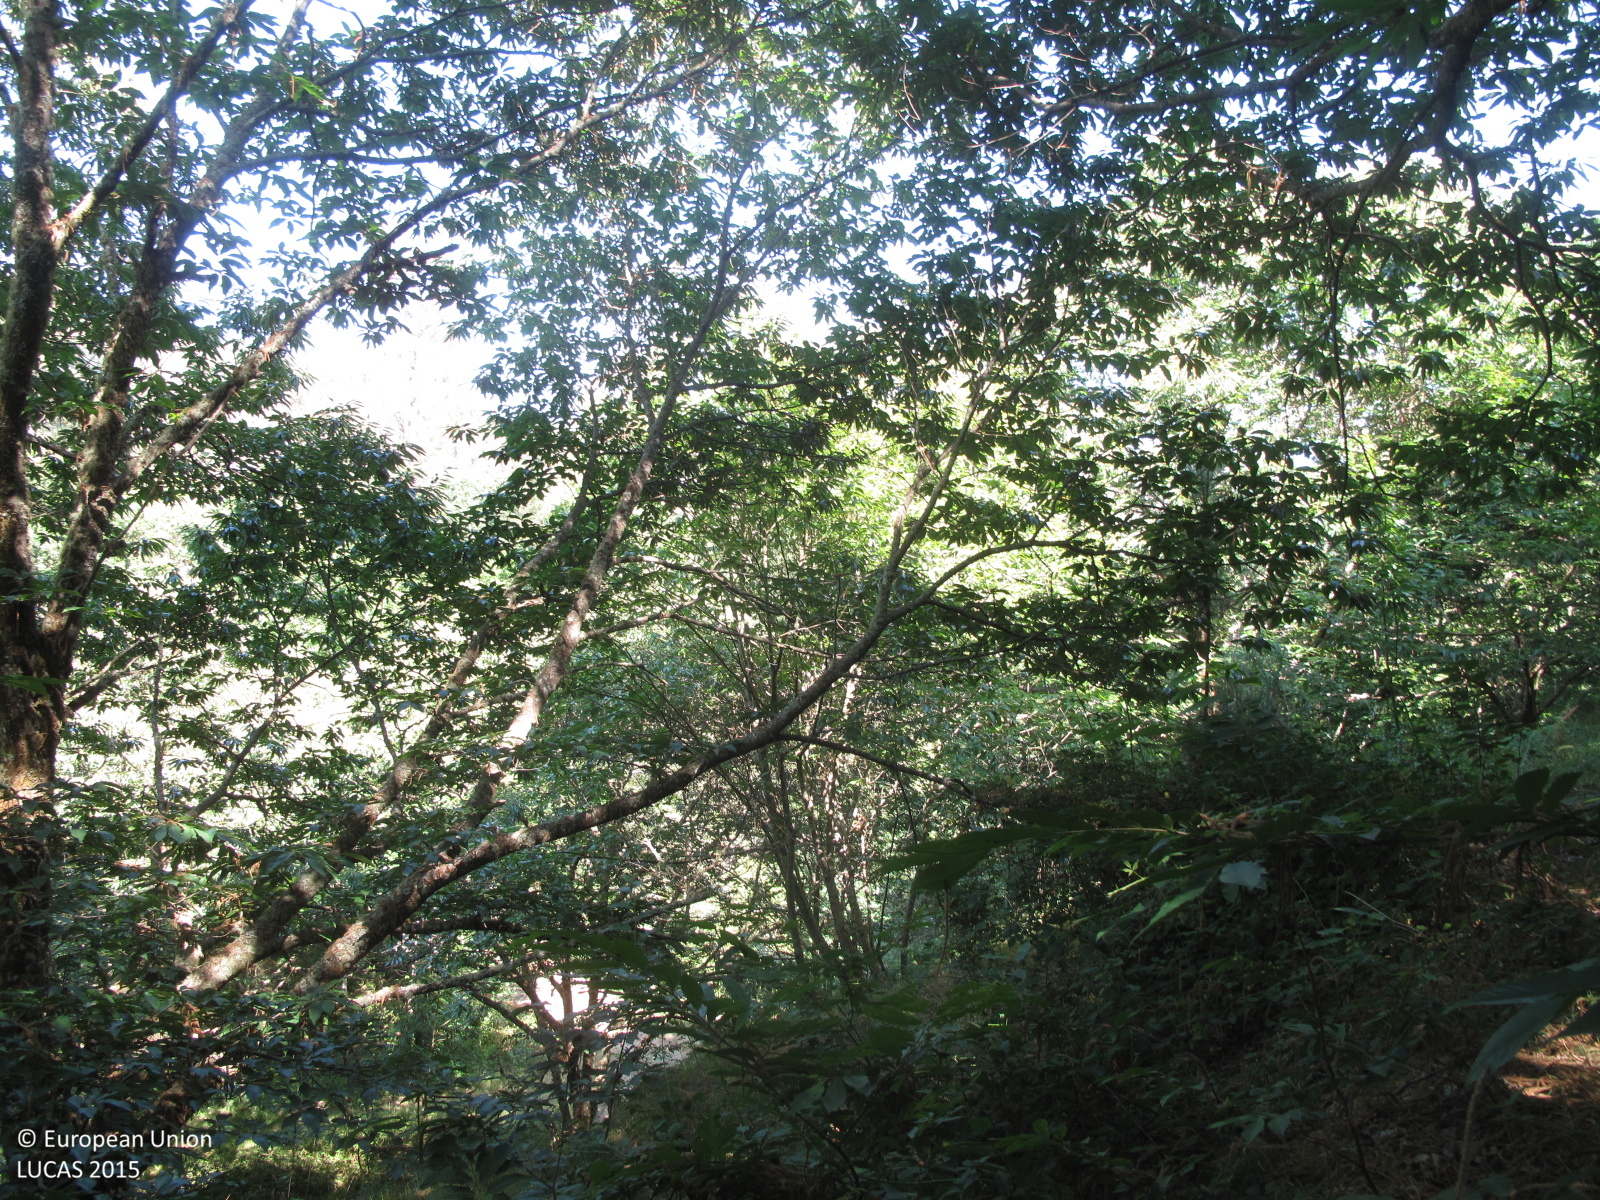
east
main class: Woodland
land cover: Broadleaved woodland
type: thermophilous deciduous forest
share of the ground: > 75 %
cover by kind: broadleaved forest trees 100 %
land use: Forestry
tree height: > 5 m
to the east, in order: Broadleaved woodland; Tracks; Broadleaved woodland; Inland fresh running water; Broadleaved woodland; Paved roads, cycling and walking lanes; Fences; Managed hedges; Grassland with sparse tree/shrub cover; Shruby margins; Grassland with sparse tree/shrub cover; Broadleaved woodland; Pine dominated coniferous woodland
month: July
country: ES
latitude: 43.3213
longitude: -8.1640
